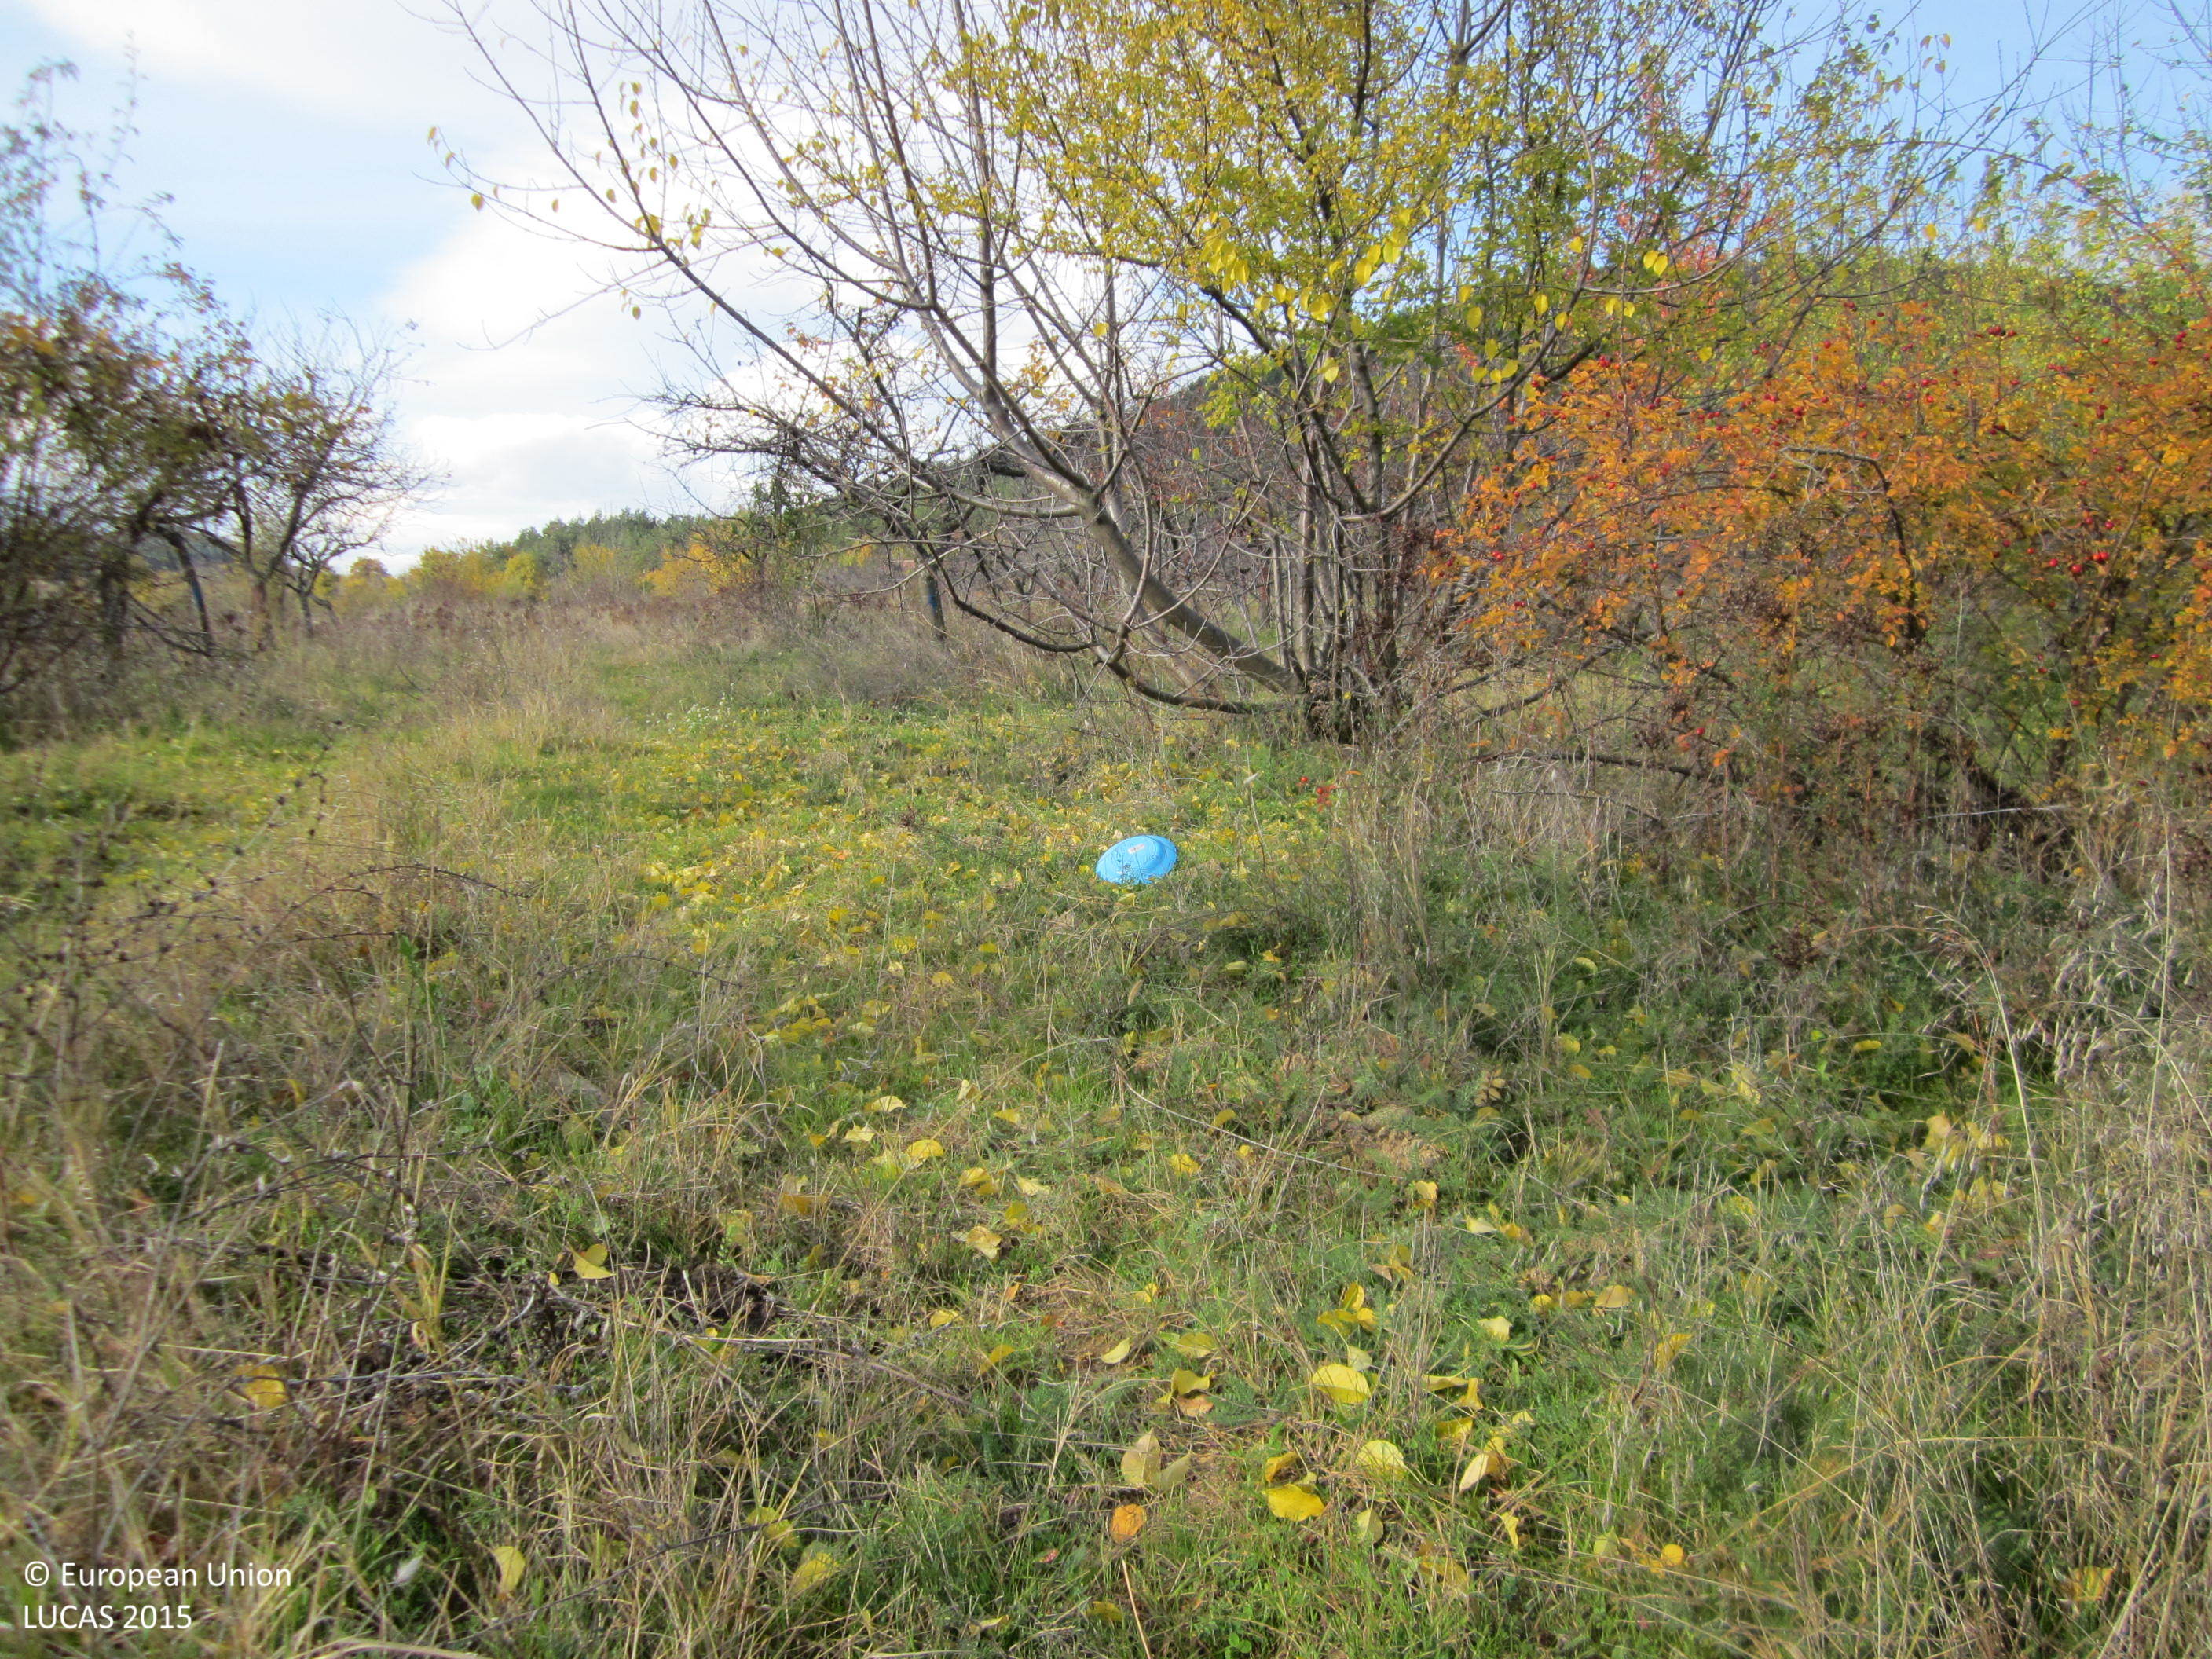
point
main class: Cropland
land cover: Cherry fruit
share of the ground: 50 - 75 %
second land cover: Grassland without tree/shrub cover
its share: > 75 %
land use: Agriculture (excluding fallow land and kitchen gardens)
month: November
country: BG
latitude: 42.5276
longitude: 24.7001
